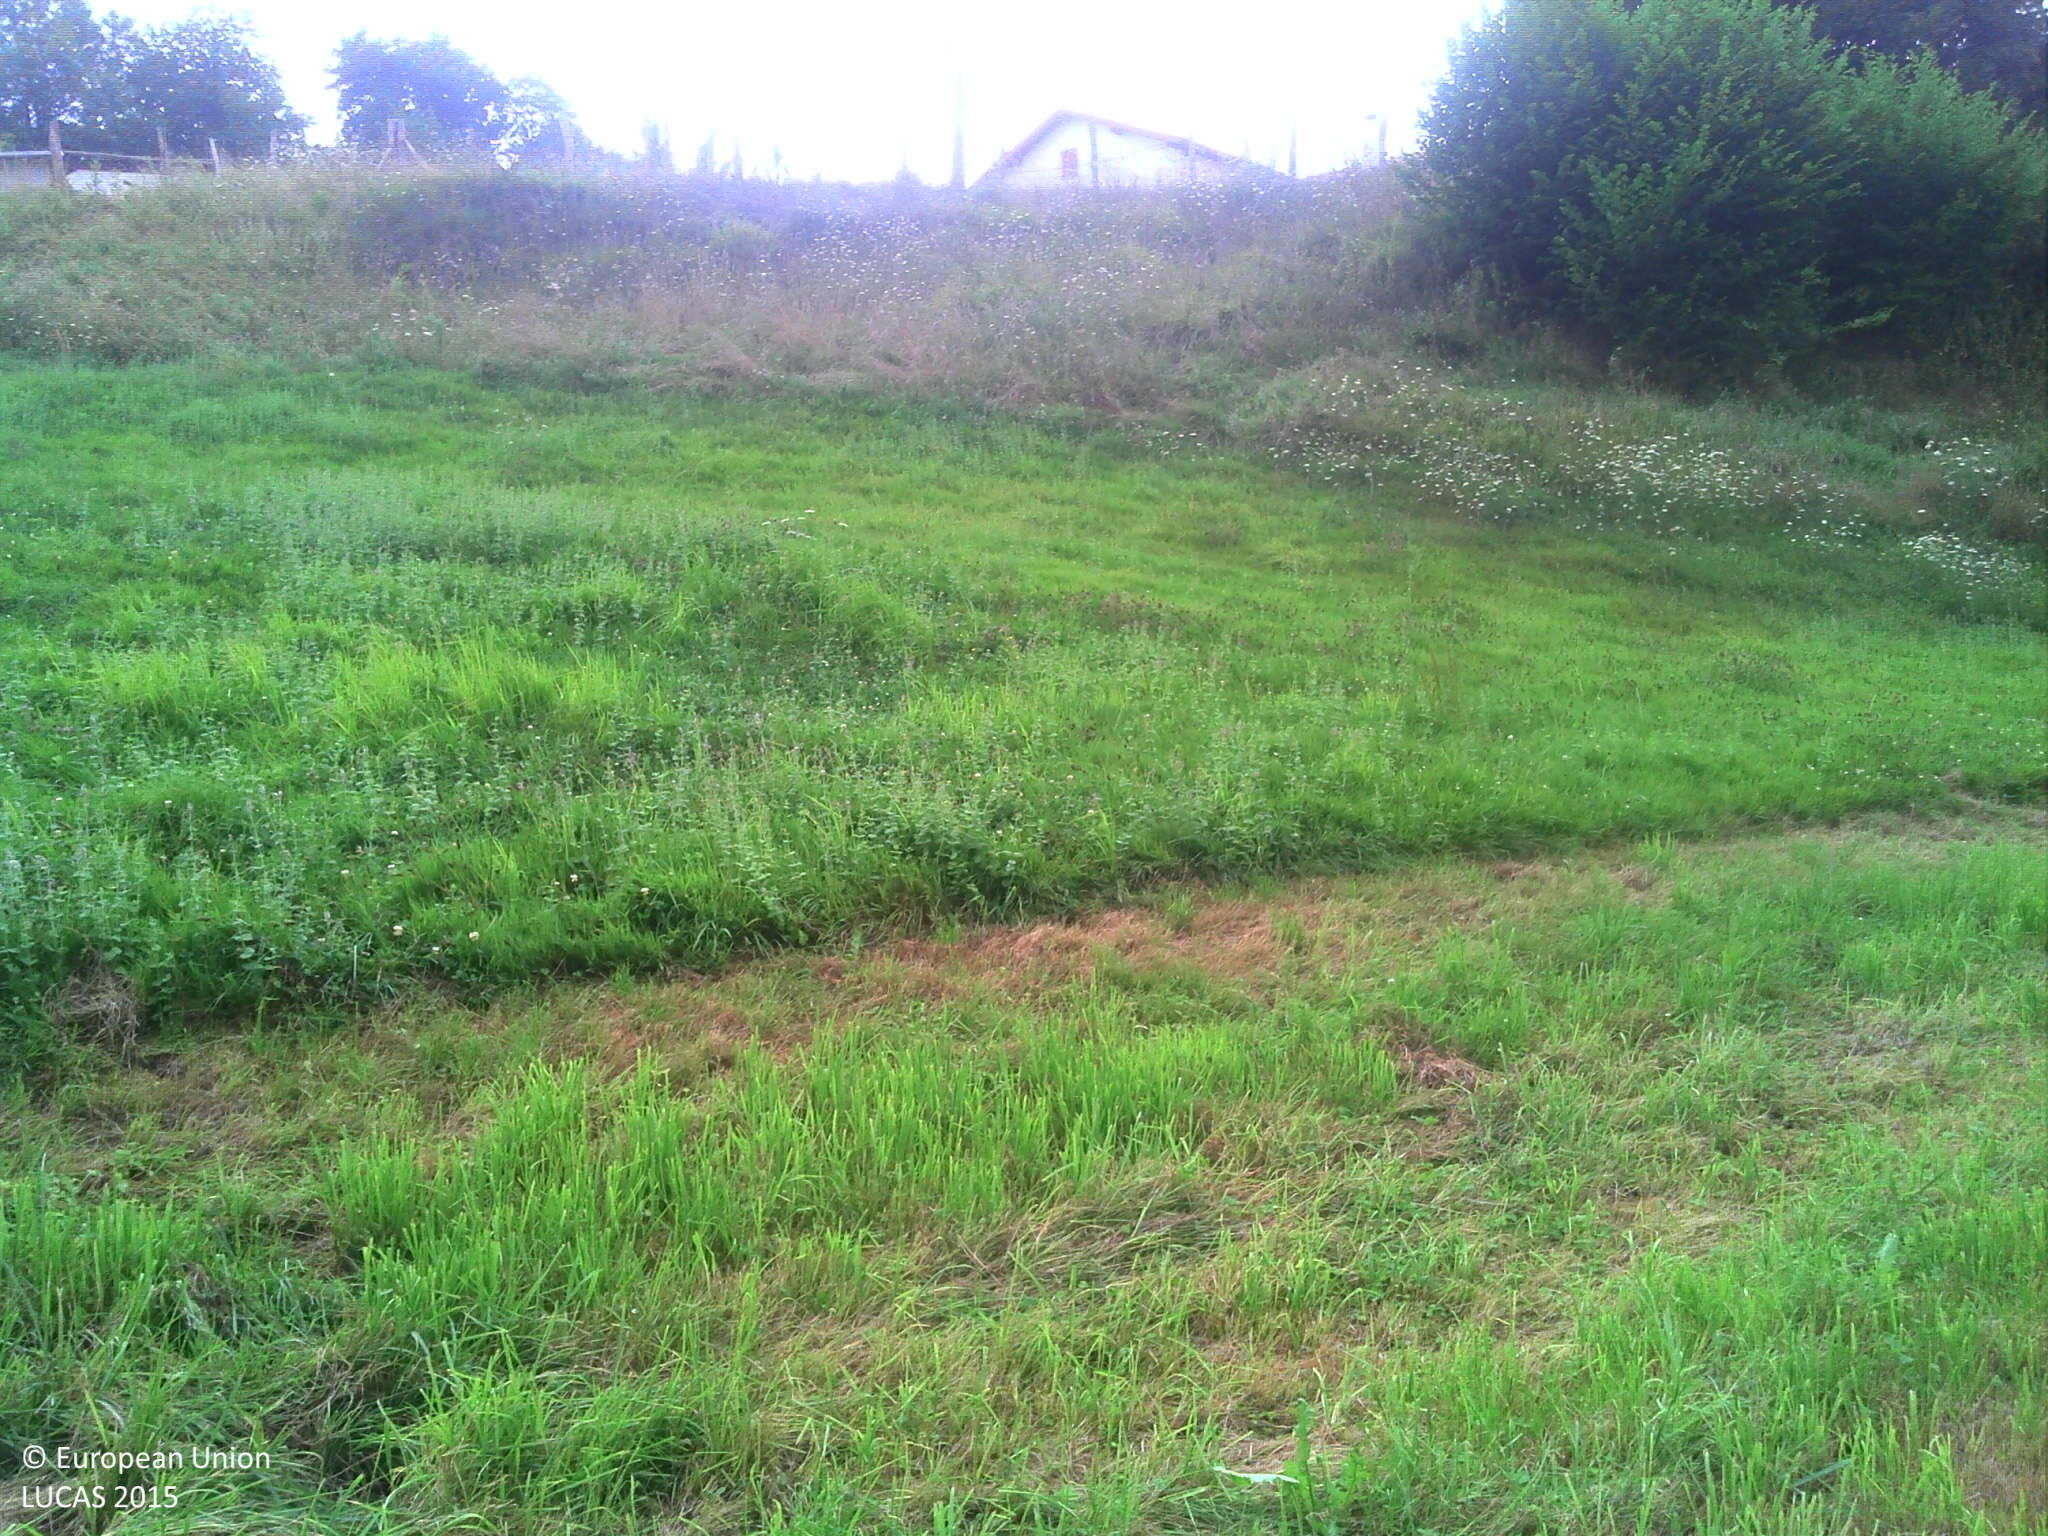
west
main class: Grassland
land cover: Grassland without tree/shrub cover
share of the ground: > 75 %
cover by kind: herbaceous plants 100 %
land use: Agriculture (excluding fallow land and kitchen gardens)
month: August
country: FR
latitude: 43.2347
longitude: -1.1819
